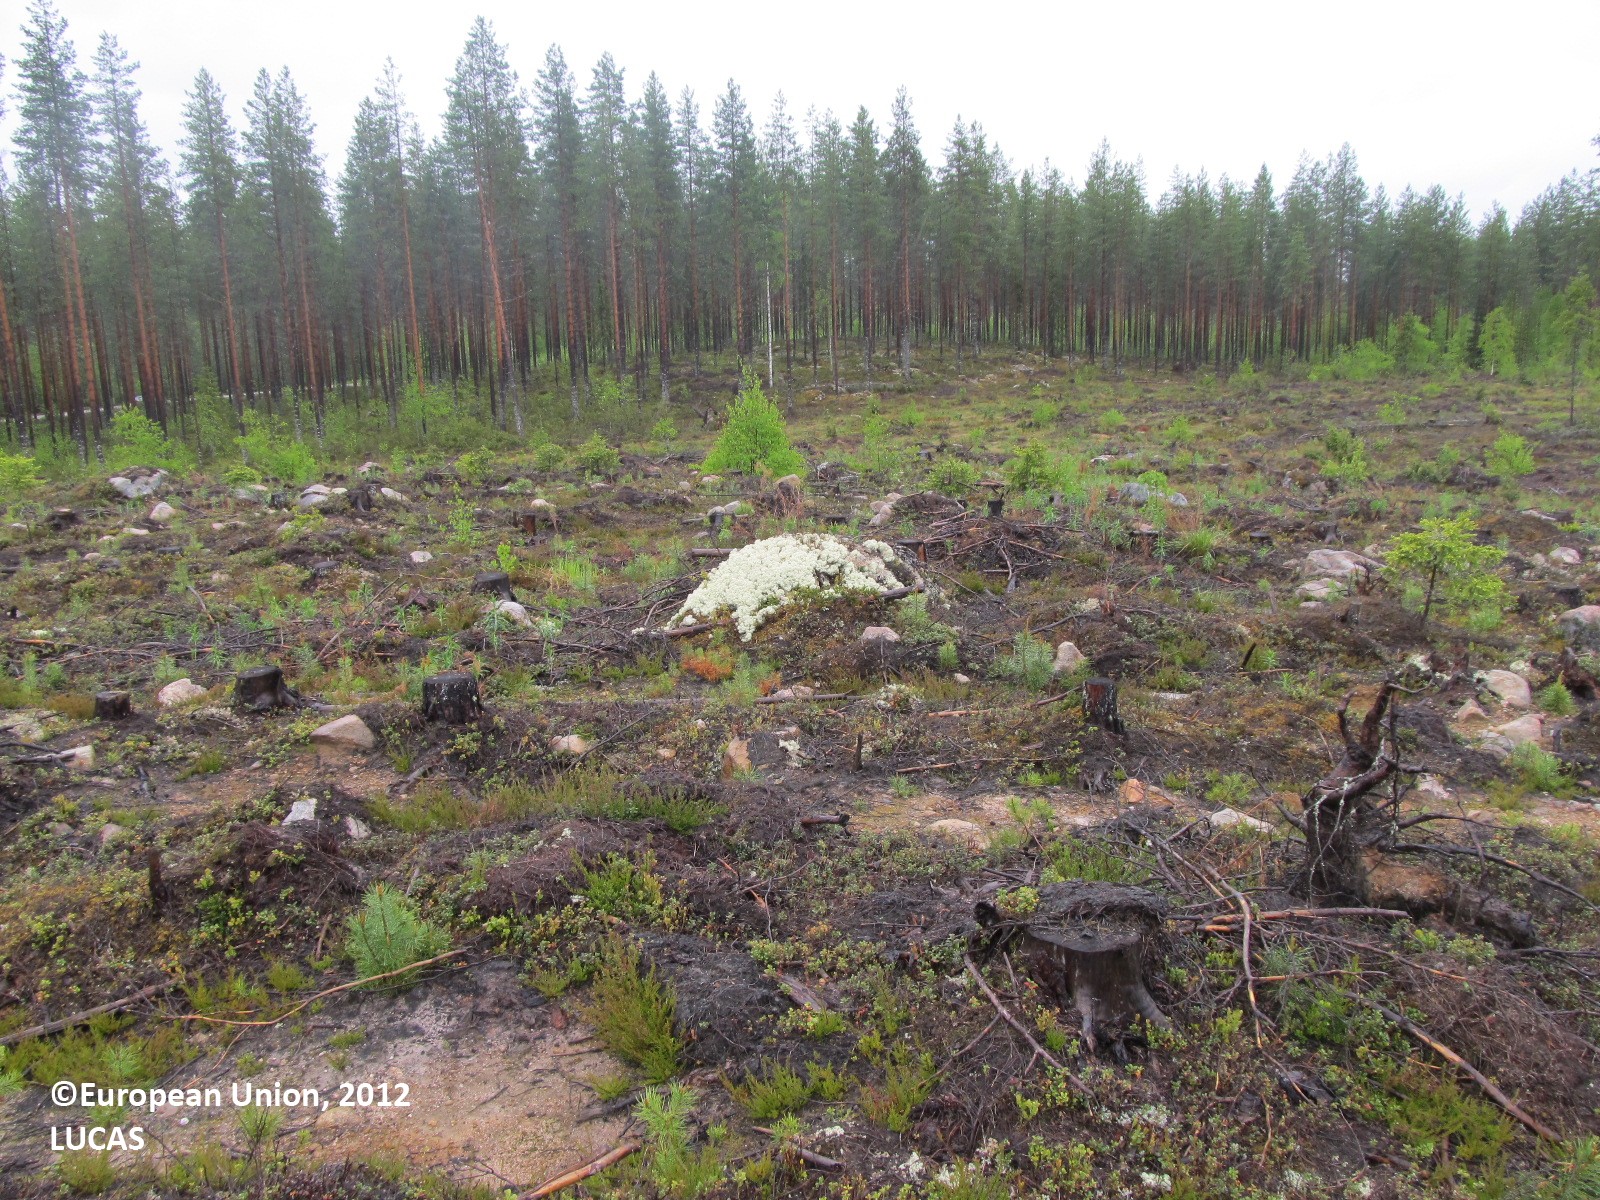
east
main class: Shrubland
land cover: Shrubland without tree cover
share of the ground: 50 - 75 %
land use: Forestry
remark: Clear cut
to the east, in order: Shrubland without tree cover; Other bare soil; Shrubland without tree cover; Other bare soil; Shrubland without tree cover; Tracks; Shrubland without tree cover; Pine dominated coniferous woodland; Tracks; Pine dominated coniferous woodland; Ditches and canals; Paved roads, cycling and walking lanes; Ditches and canals; Pine dominated coniferous woodland; Other mixed woodland
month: June
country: FI
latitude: 63.3061
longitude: 29.1511
